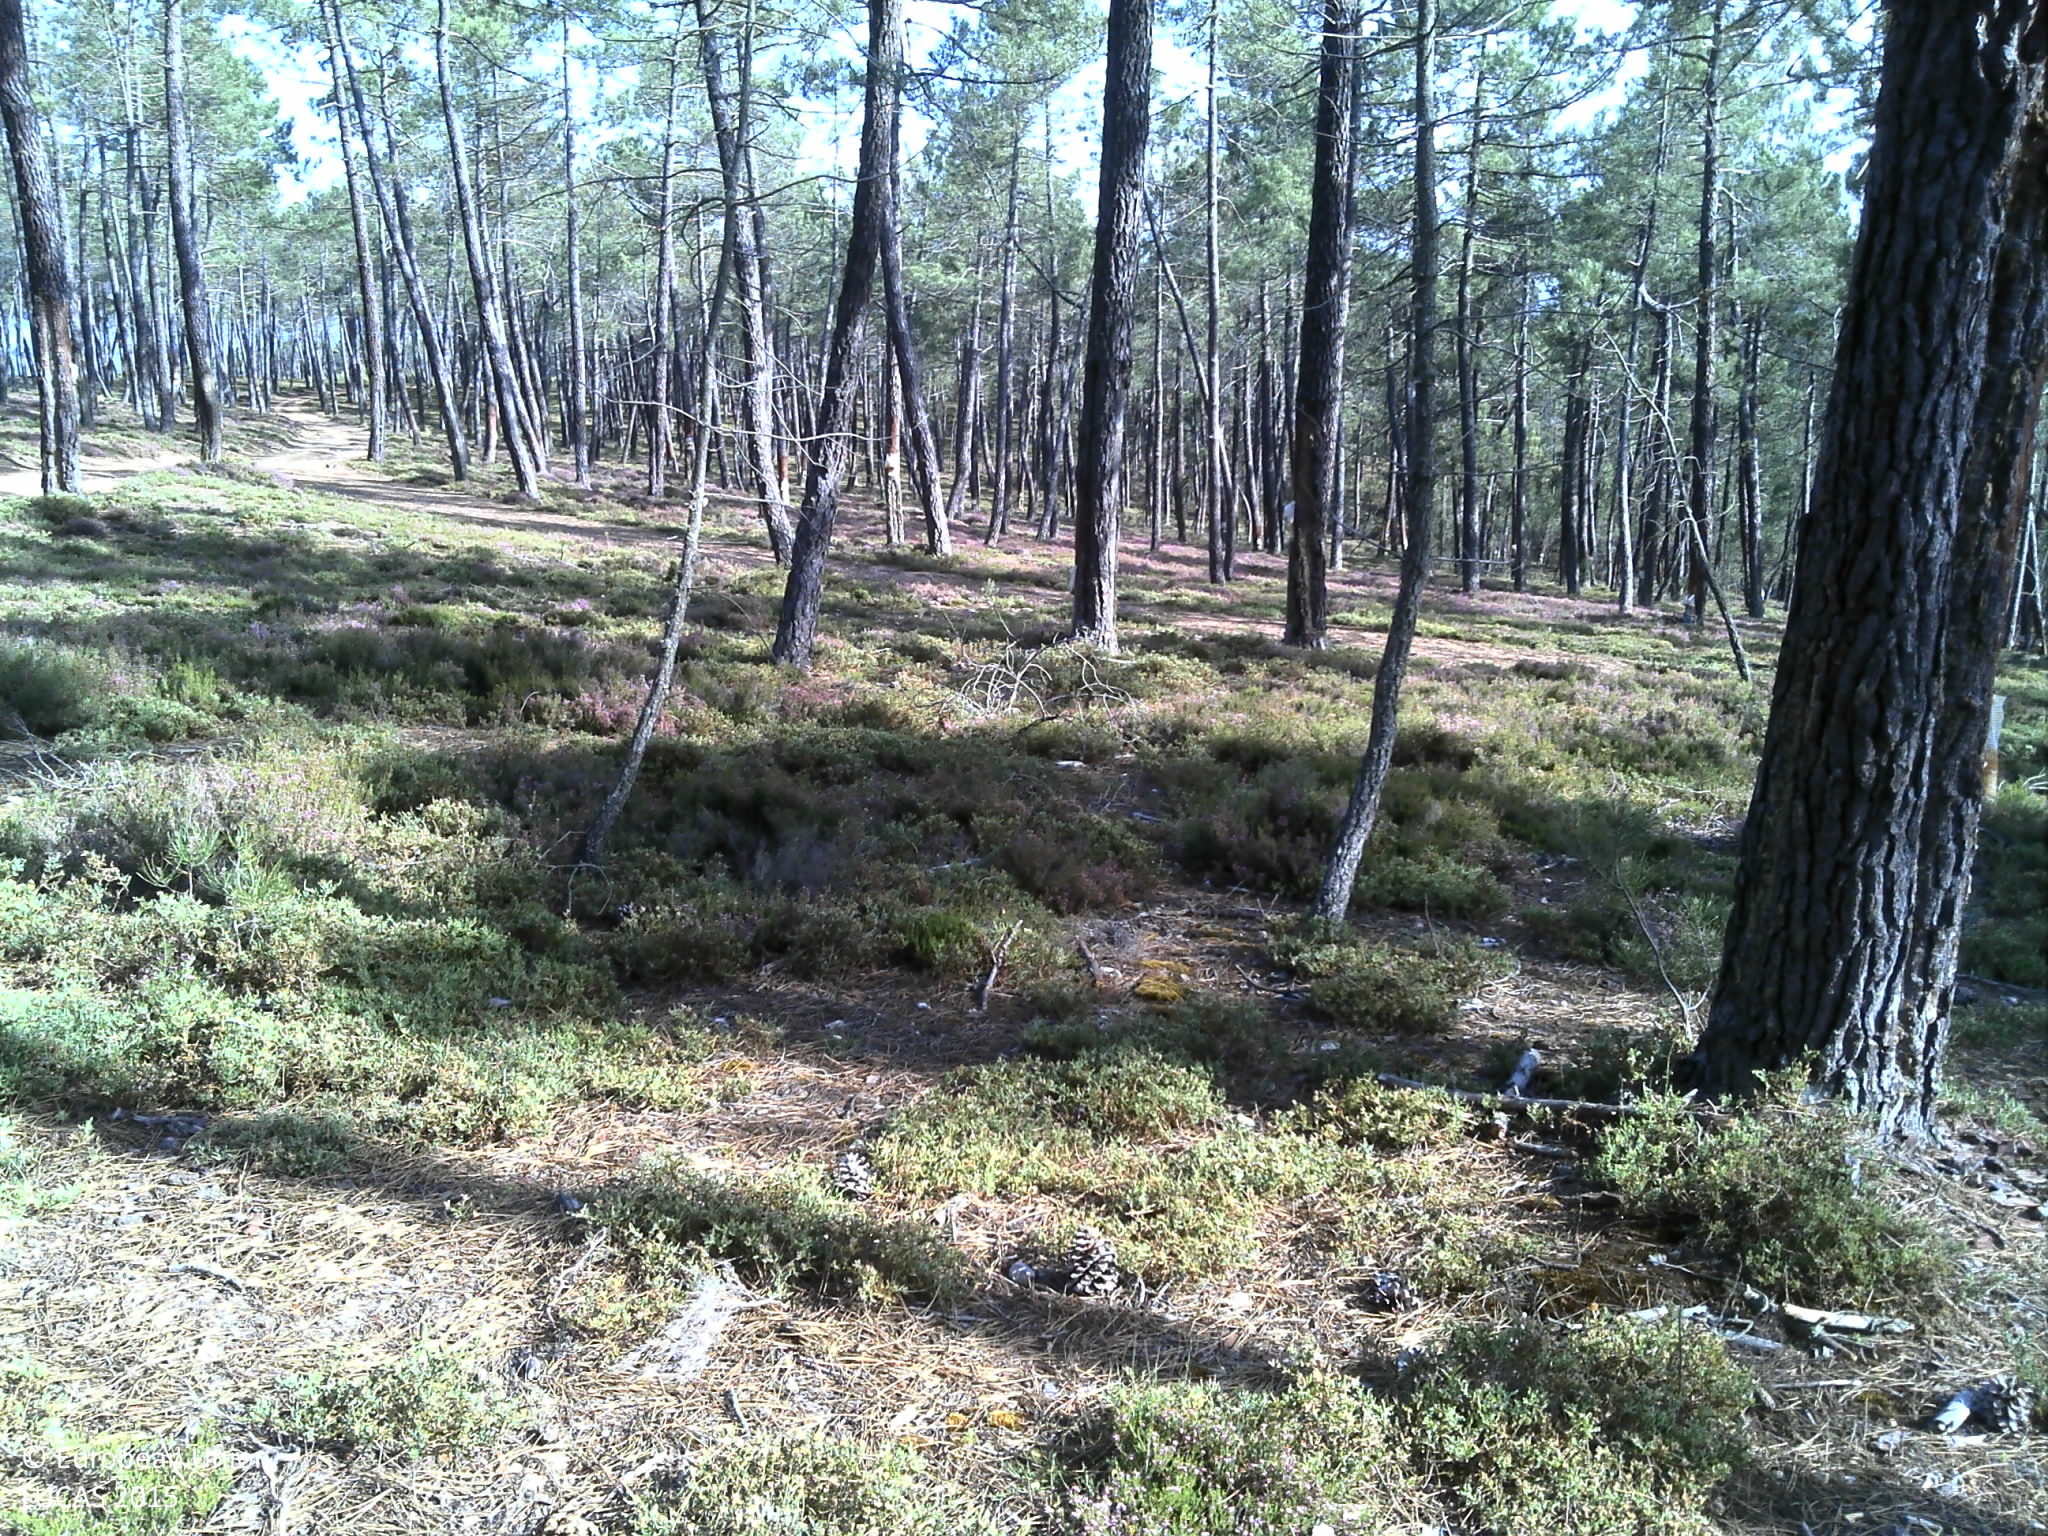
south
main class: Woodland
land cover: Pine dominated coniferous woodland
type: coniferous forest of the mediterranean region
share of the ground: 25 - 50 %
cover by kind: coniferous forest trees 40 %, shrubs 40 %, unconsolidated bare surface 20 %
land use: Forestry
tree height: > 5 m
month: May
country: PT
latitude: 41.4843
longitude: -7.5051
